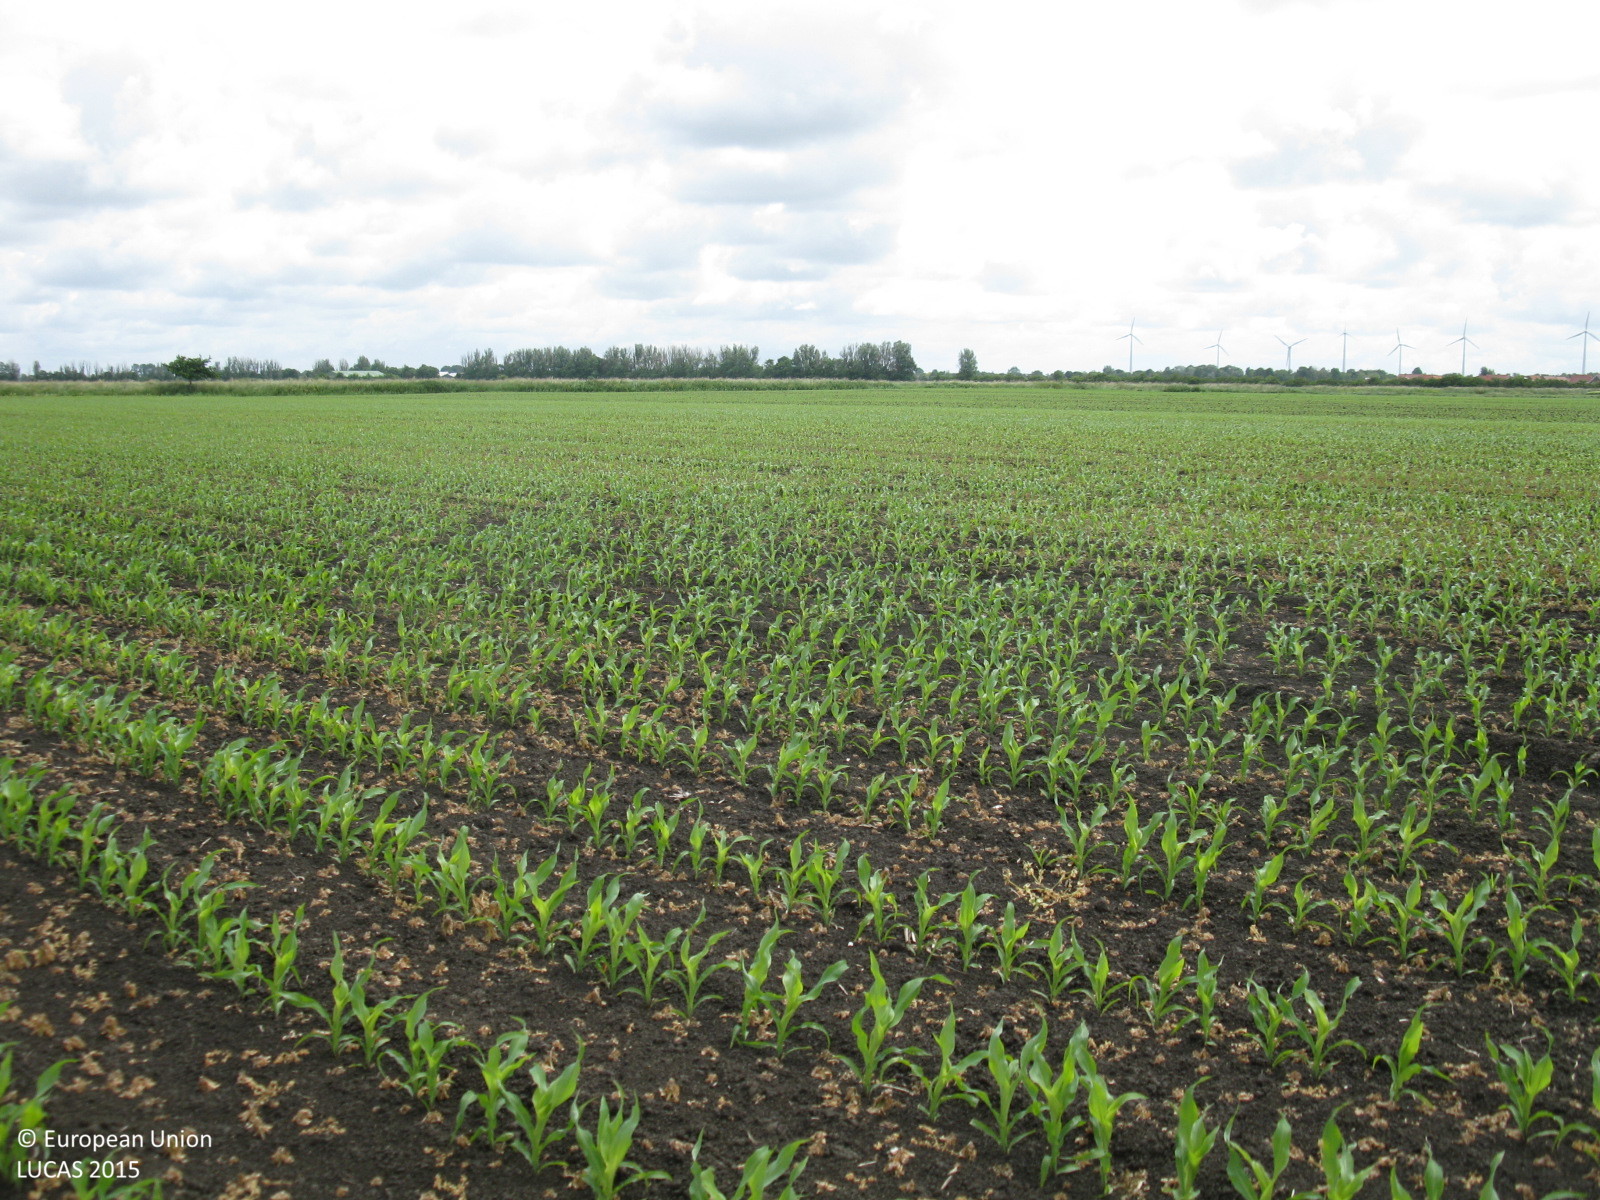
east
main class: Cropland
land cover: Maize
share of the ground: 10 - 25 %
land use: Agriculture (excluding fallow land and kitchen gardens)
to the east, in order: Maize; Grassland without tree/shrub cover; Paved roads, cycling and walking lanes; Grassland without tree/shrub cover; Maize
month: June
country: DE
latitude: 53.4087
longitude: 7.3380
